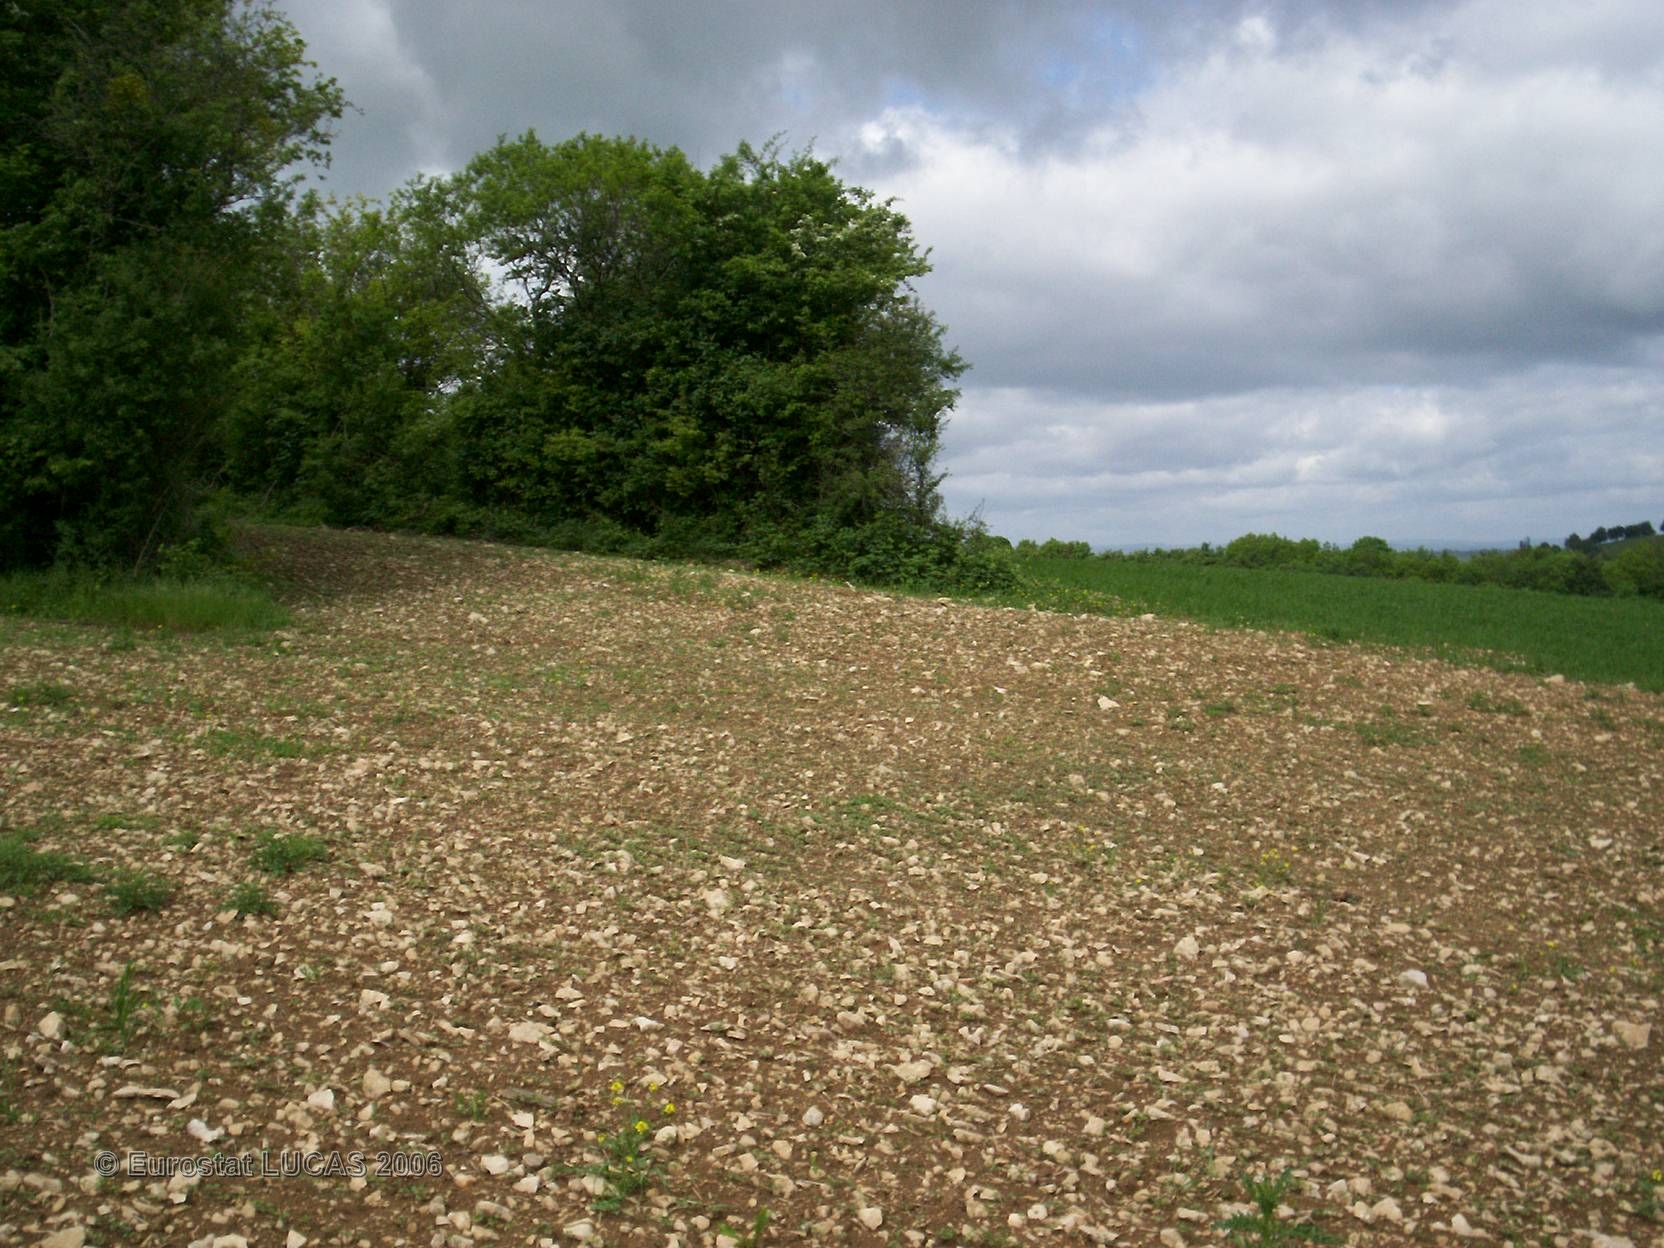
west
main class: Cropland
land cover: Clovers
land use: Fallow land
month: May
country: FR
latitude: 47.0843
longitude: 4.6657
